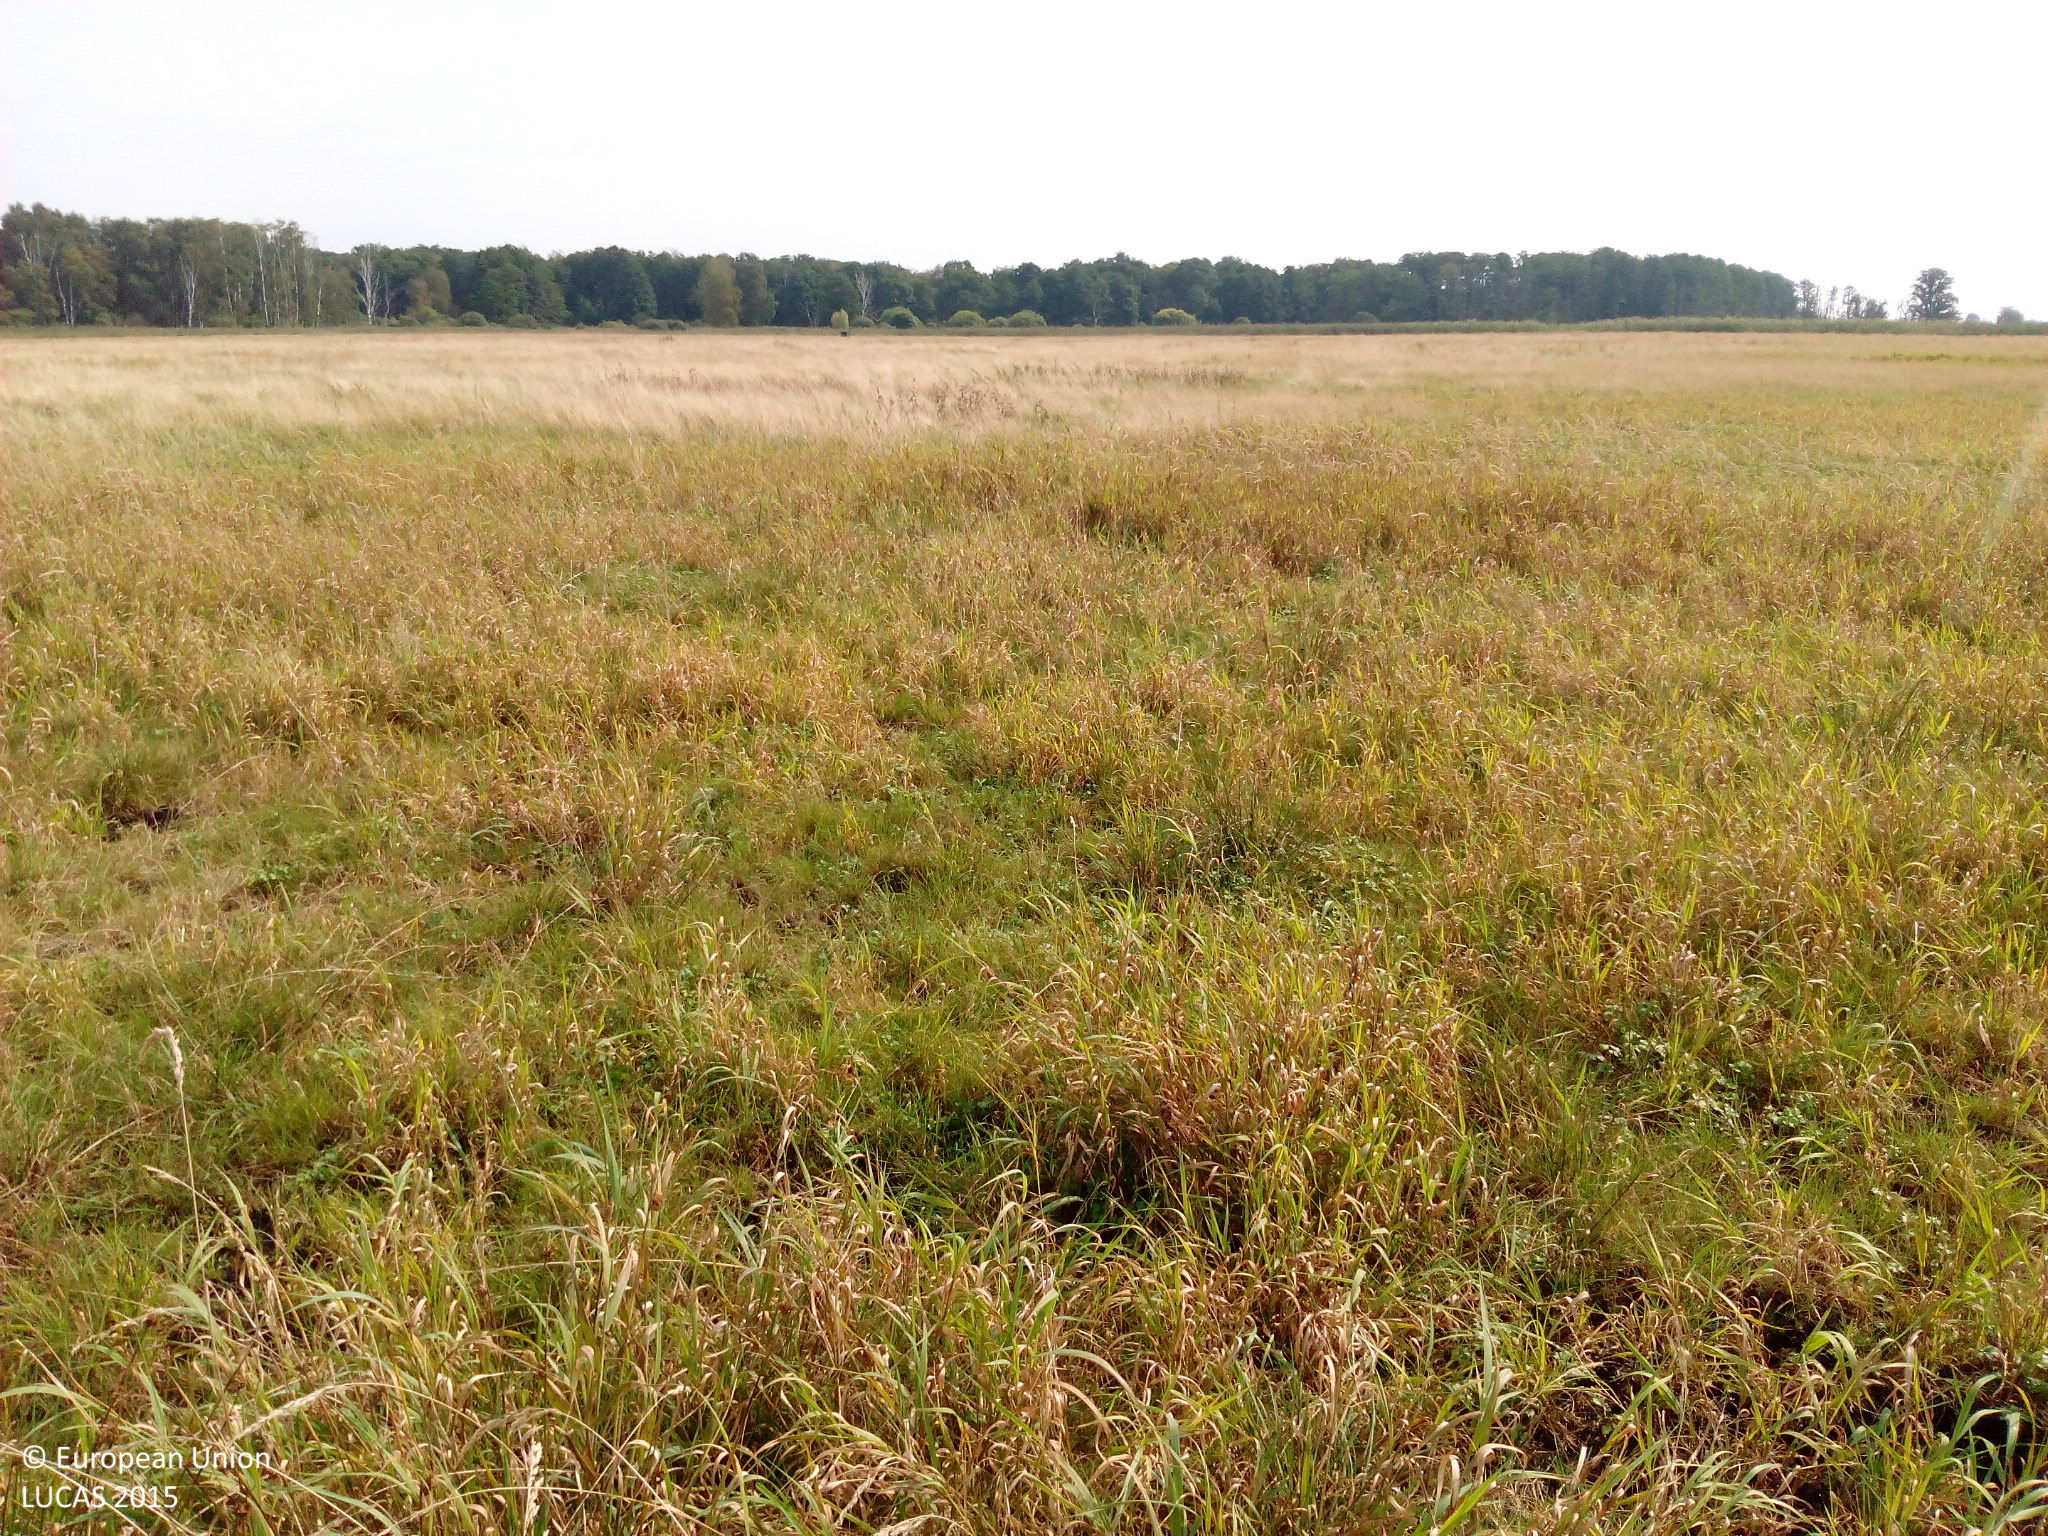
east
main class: Grassland
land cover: Grassland without tree/shrub cover
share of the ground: > 75 %
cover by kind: herbaceous plants 100 %
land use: Agriculture (excluding fallow land and kitchen gardens)
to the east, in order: Grassland without tree/shrub cover
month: August
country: DE
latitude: 54.1469
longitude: 12.6170
